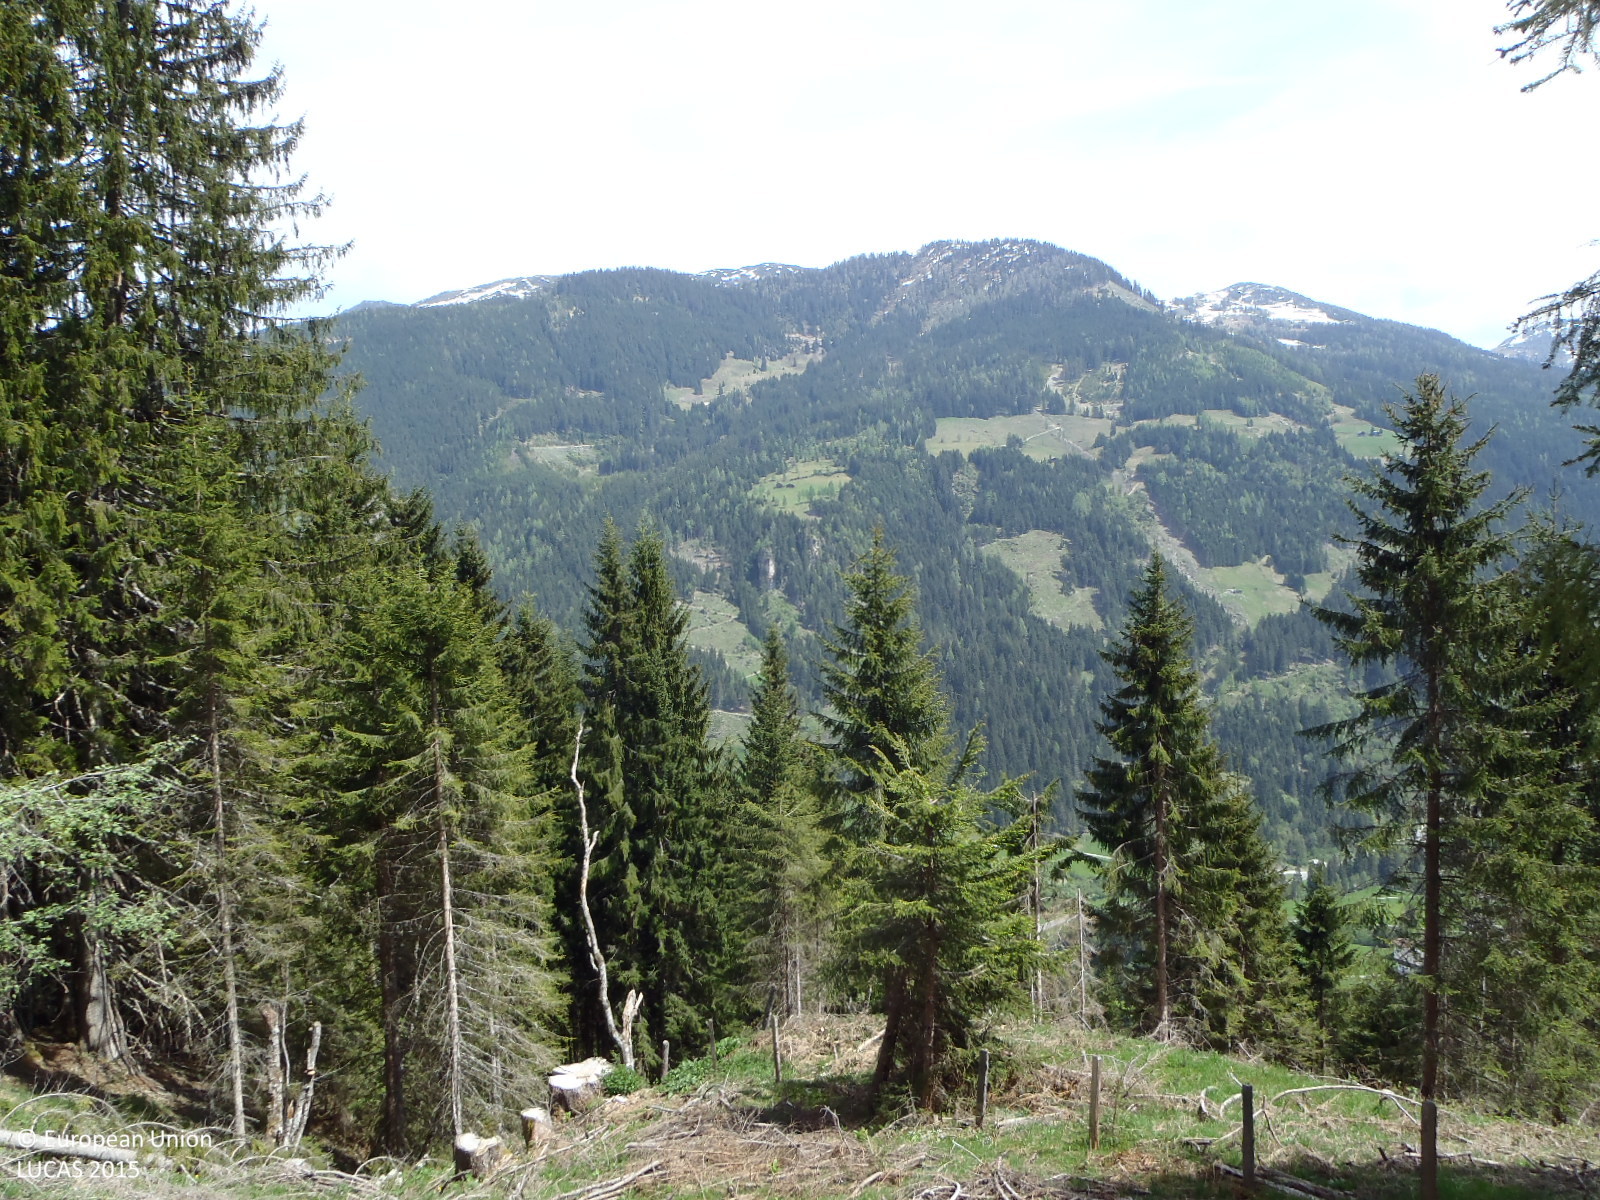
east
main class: Woodland
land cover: Spruce dominated coniferous woodland
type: alpine coniferous forest
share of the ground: 10 - 25 %
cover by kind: herbaceous plants 75 %, coniferous forest trees 20 %, shrubs 5 %
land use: Forestry
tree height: > 5 m
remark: Clear cut
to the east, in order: Spruce dominated coniferous woodland; Fences; Spruce dominated coniferous woodland; Fences; Rivers and streams; Spruce dominated coniferous woodland; Rocks and stones; Tracks; Grass margins; Dry stone walls; Ditches and canals; Tracks; Broadleaved woodland; Rivers and streams; Groves; Grassland without tree/shrub cover; Electric lines; Grassland without tree/shrub cover
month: May
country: AT
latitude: 47.3098
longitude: 13.2918
